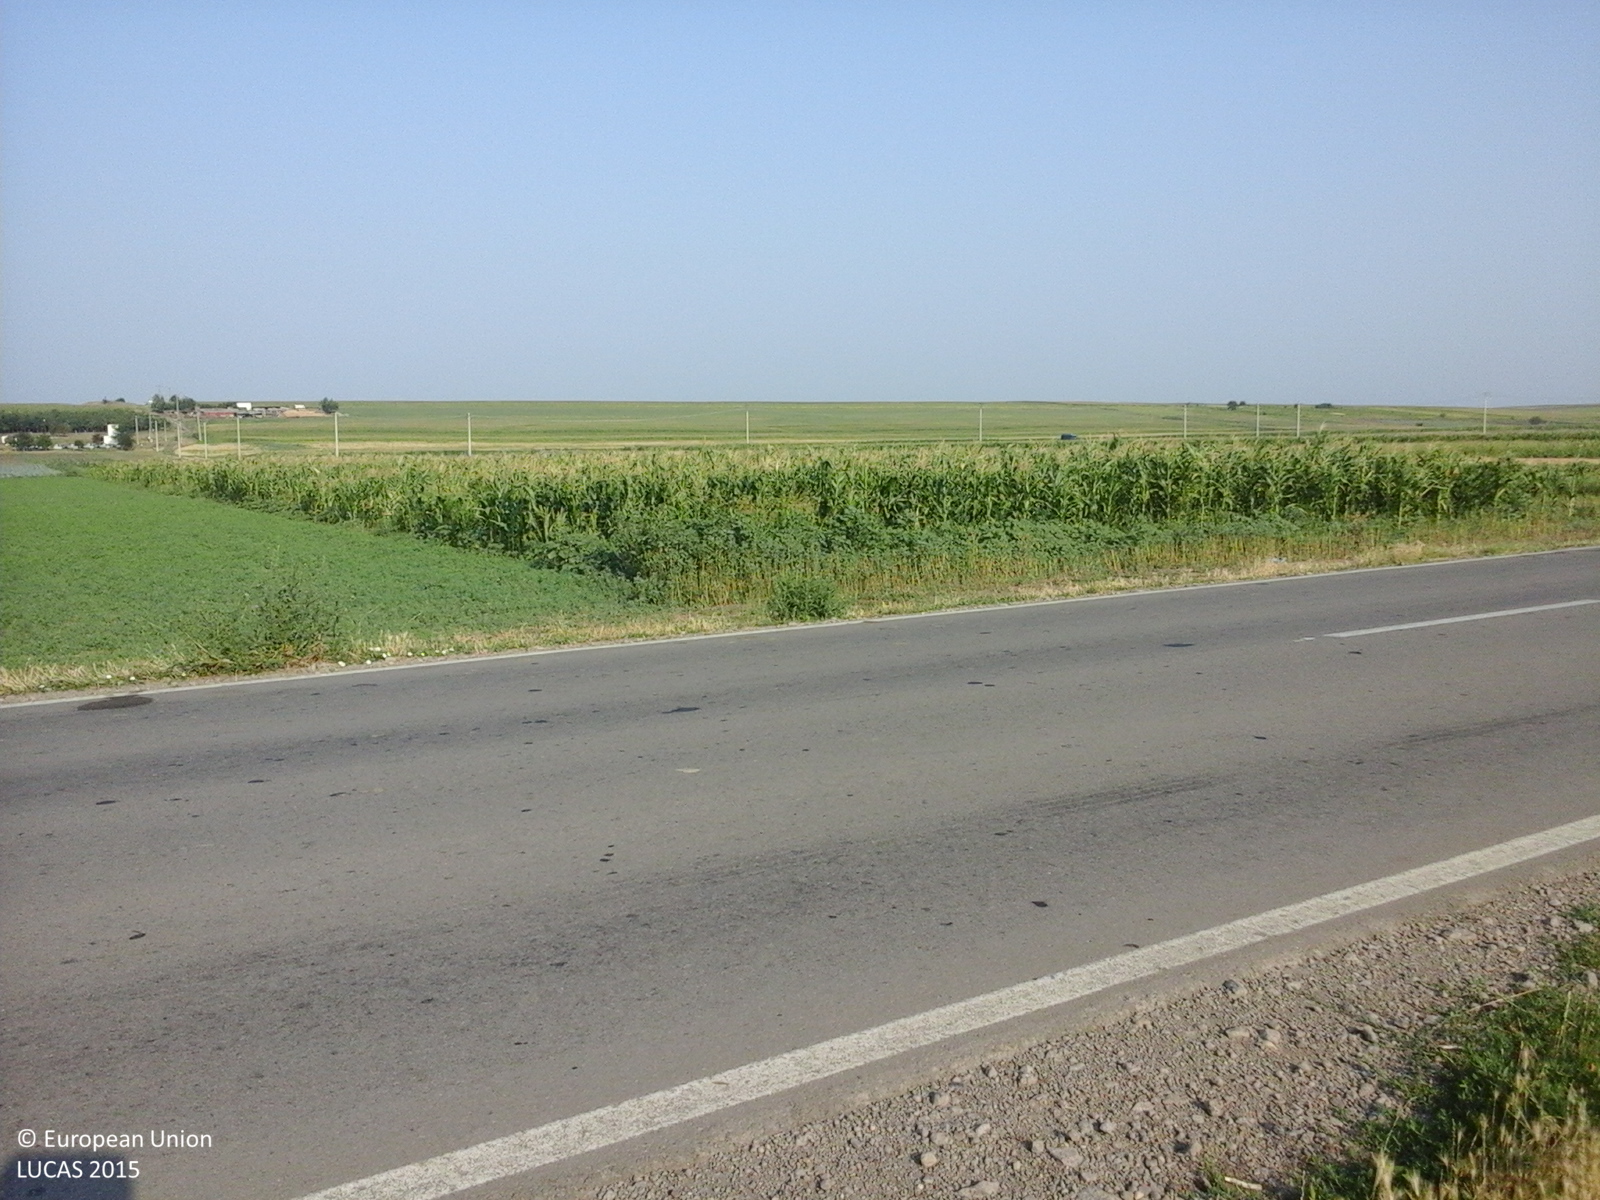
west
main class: Cropland
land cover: Vineyards
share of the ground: 50 - 75 %
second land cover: Grassland without tree/shrub cover
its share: > 75 %
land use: Agriculture (excluding fallow land and kitchen gardens)
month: July
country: RO
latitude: 45.7256
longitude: 27.7008
